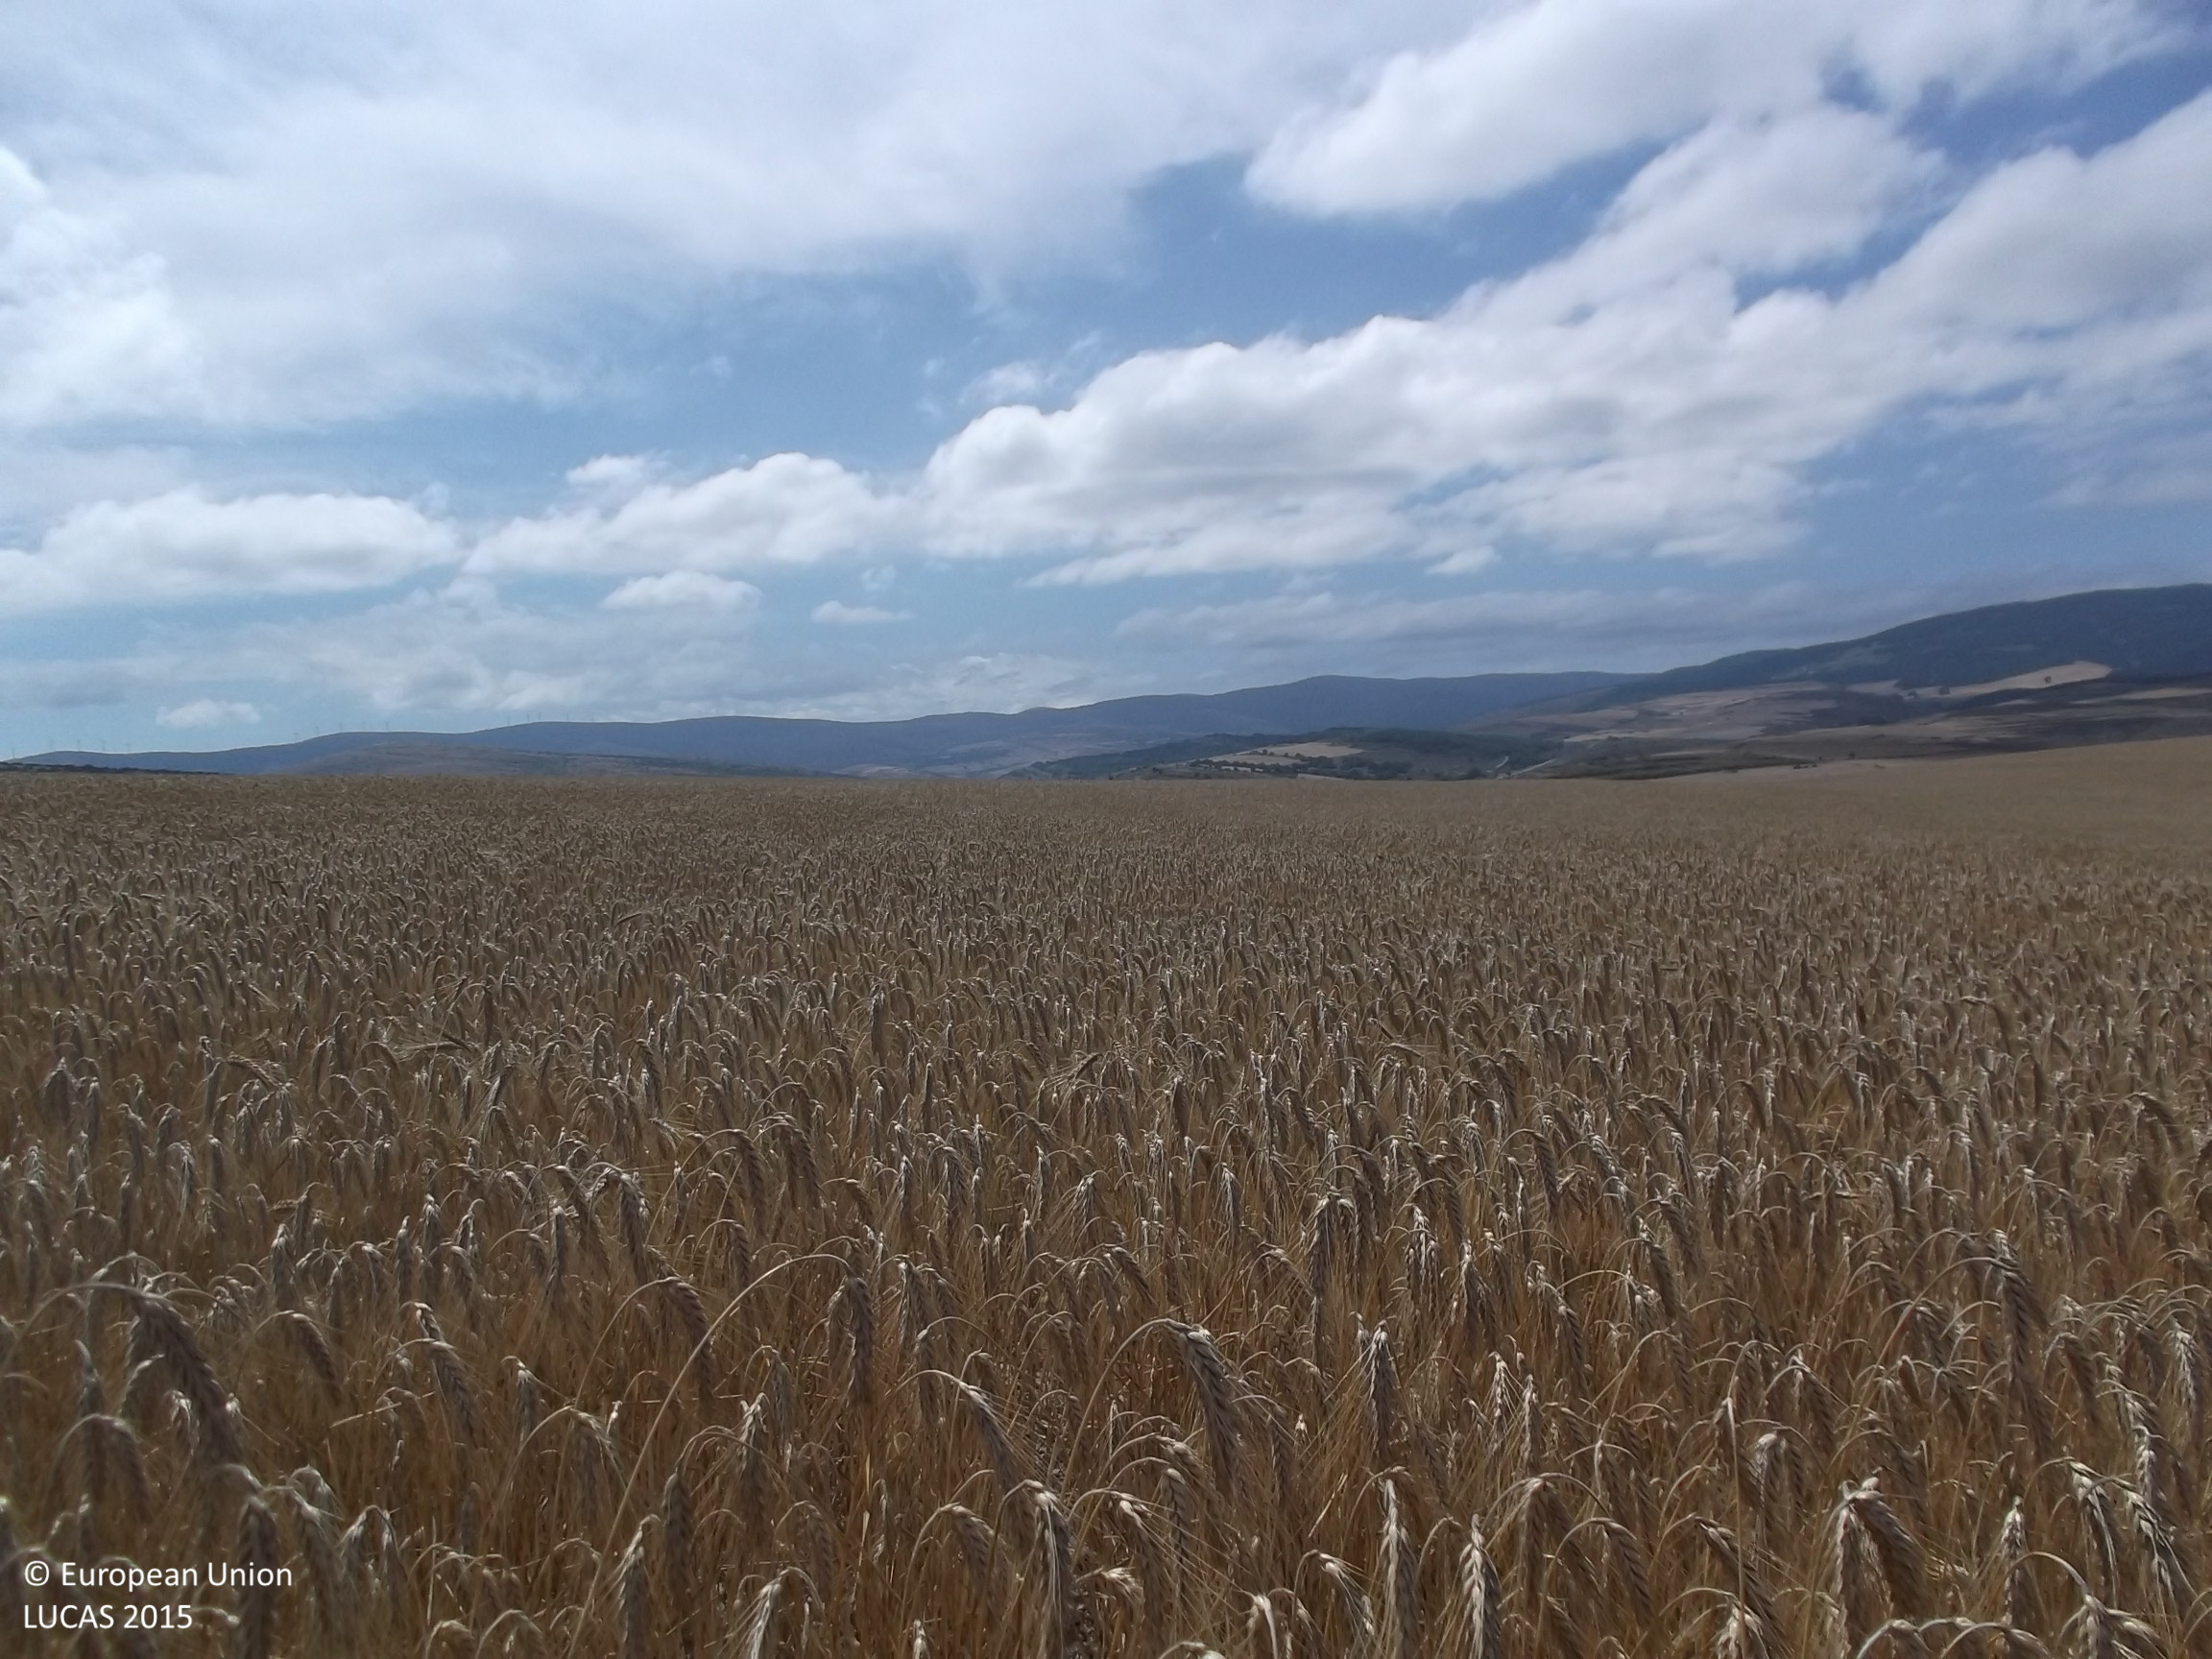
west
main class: Cropland
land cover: Rye
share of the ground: > 75 %
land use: Agriculture (excluding fallow land and kitchen gardens)
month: July
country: ES
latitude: 42.0589
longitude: -2.3532
